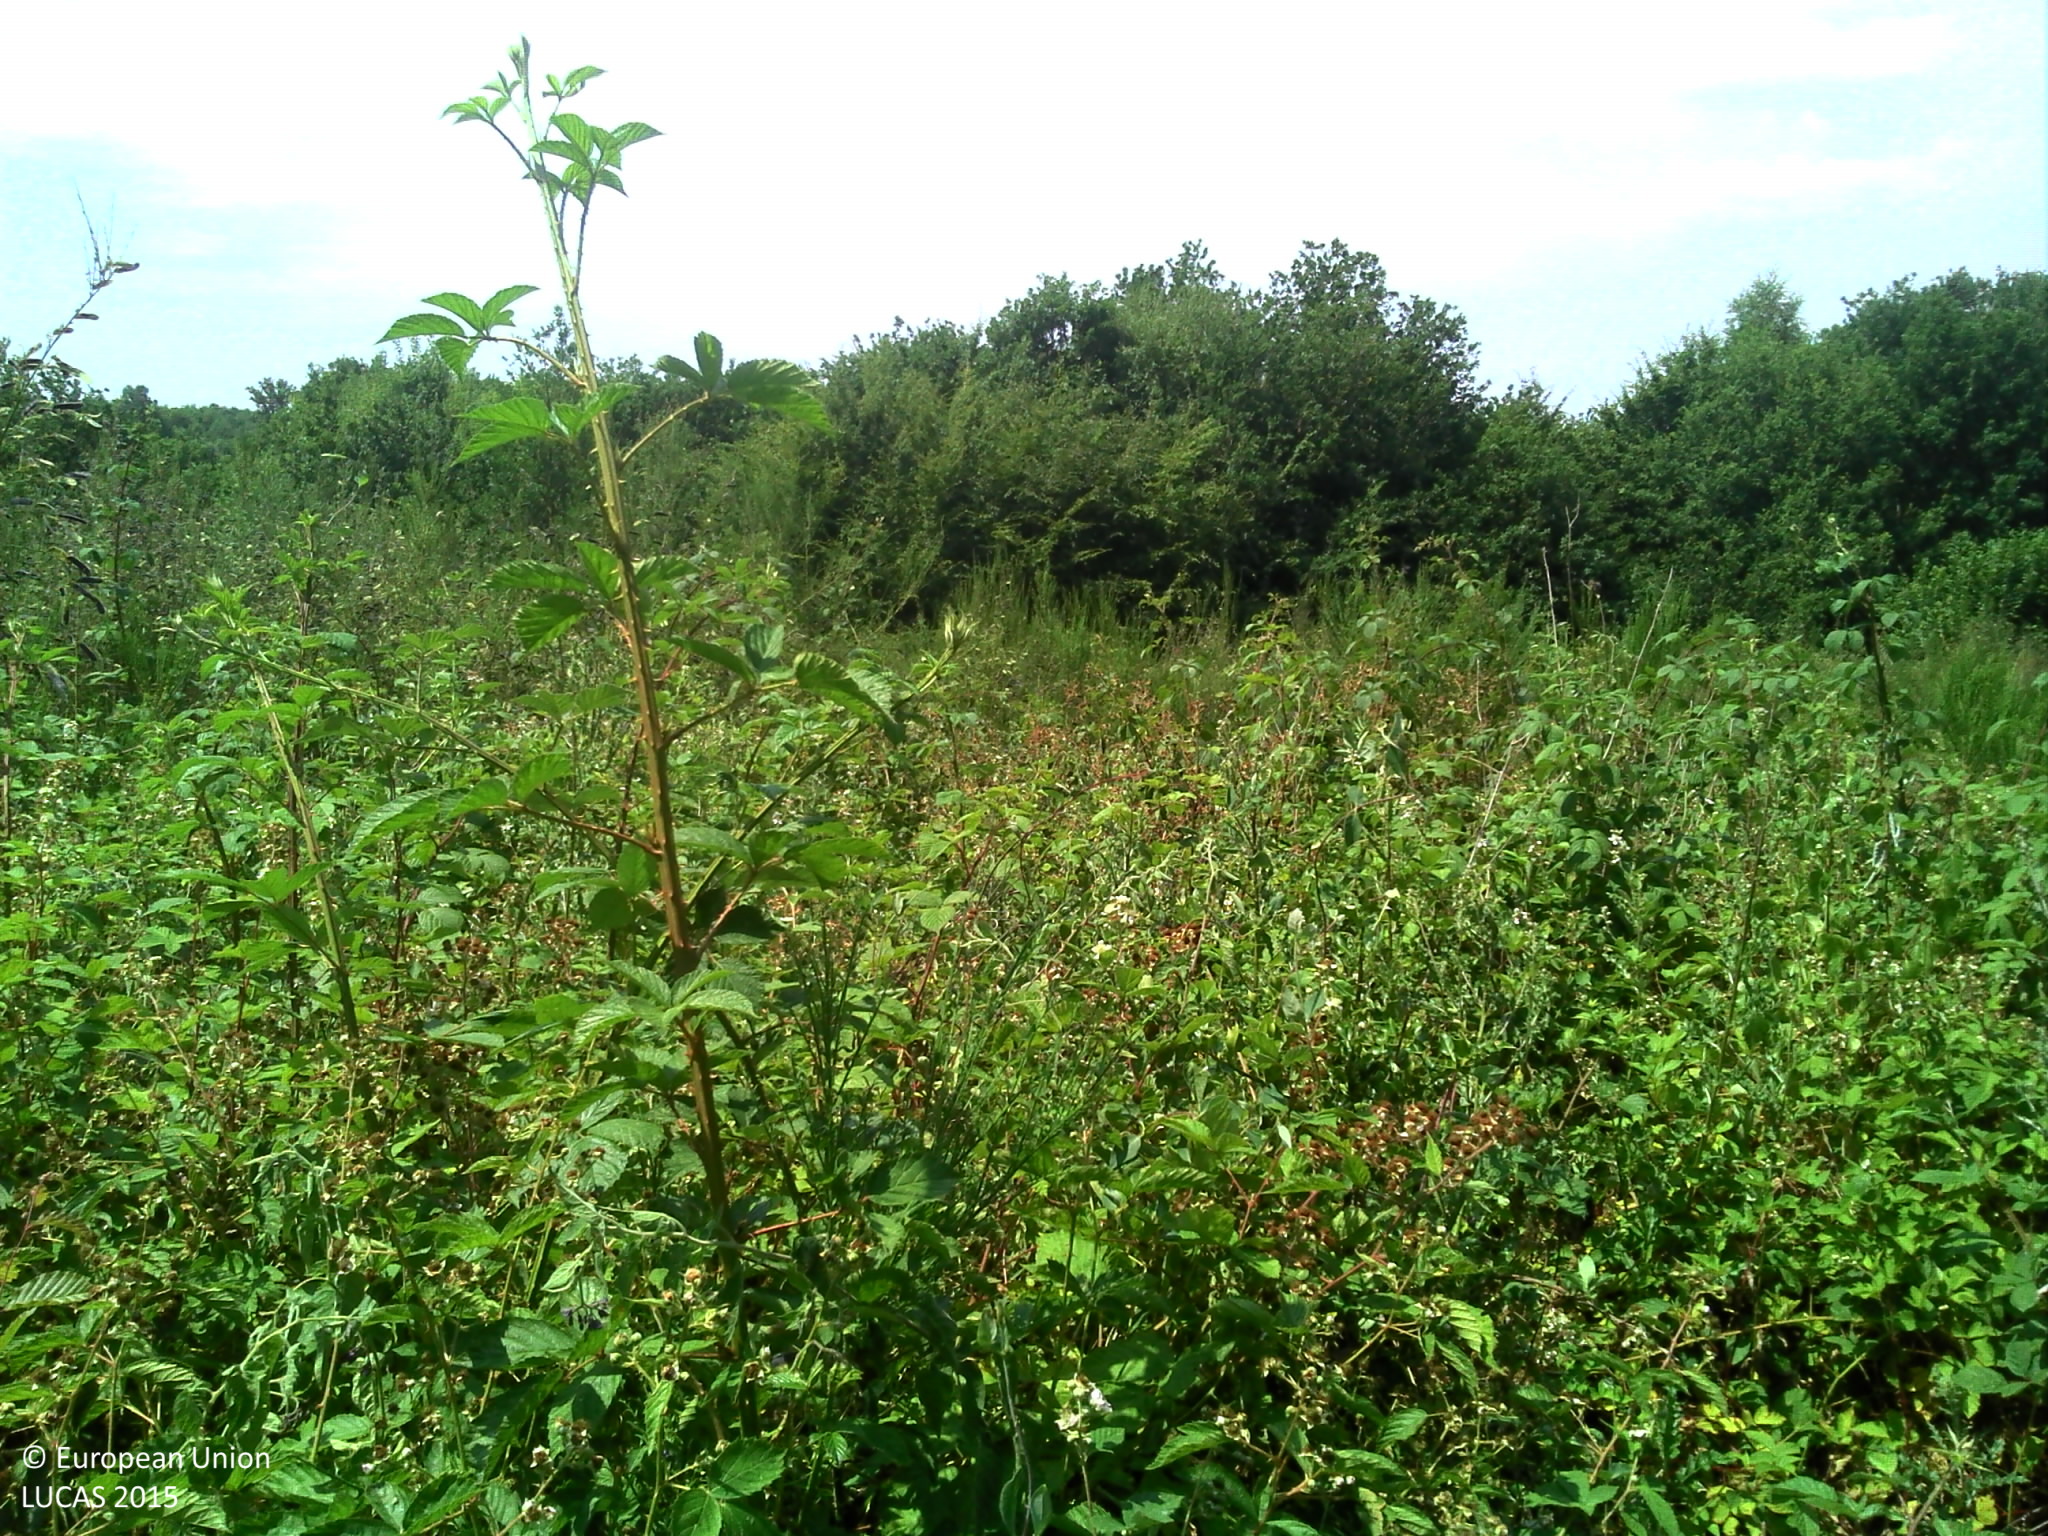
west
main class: Shrubland
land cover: Shrubland without tree cover
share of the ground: > 75 %
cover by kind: herbaceous plants 60 %, shrubs 40 %
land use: Forestry
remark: Clear cut
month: July
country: FR
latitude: 48.8119
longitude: 1.1970
